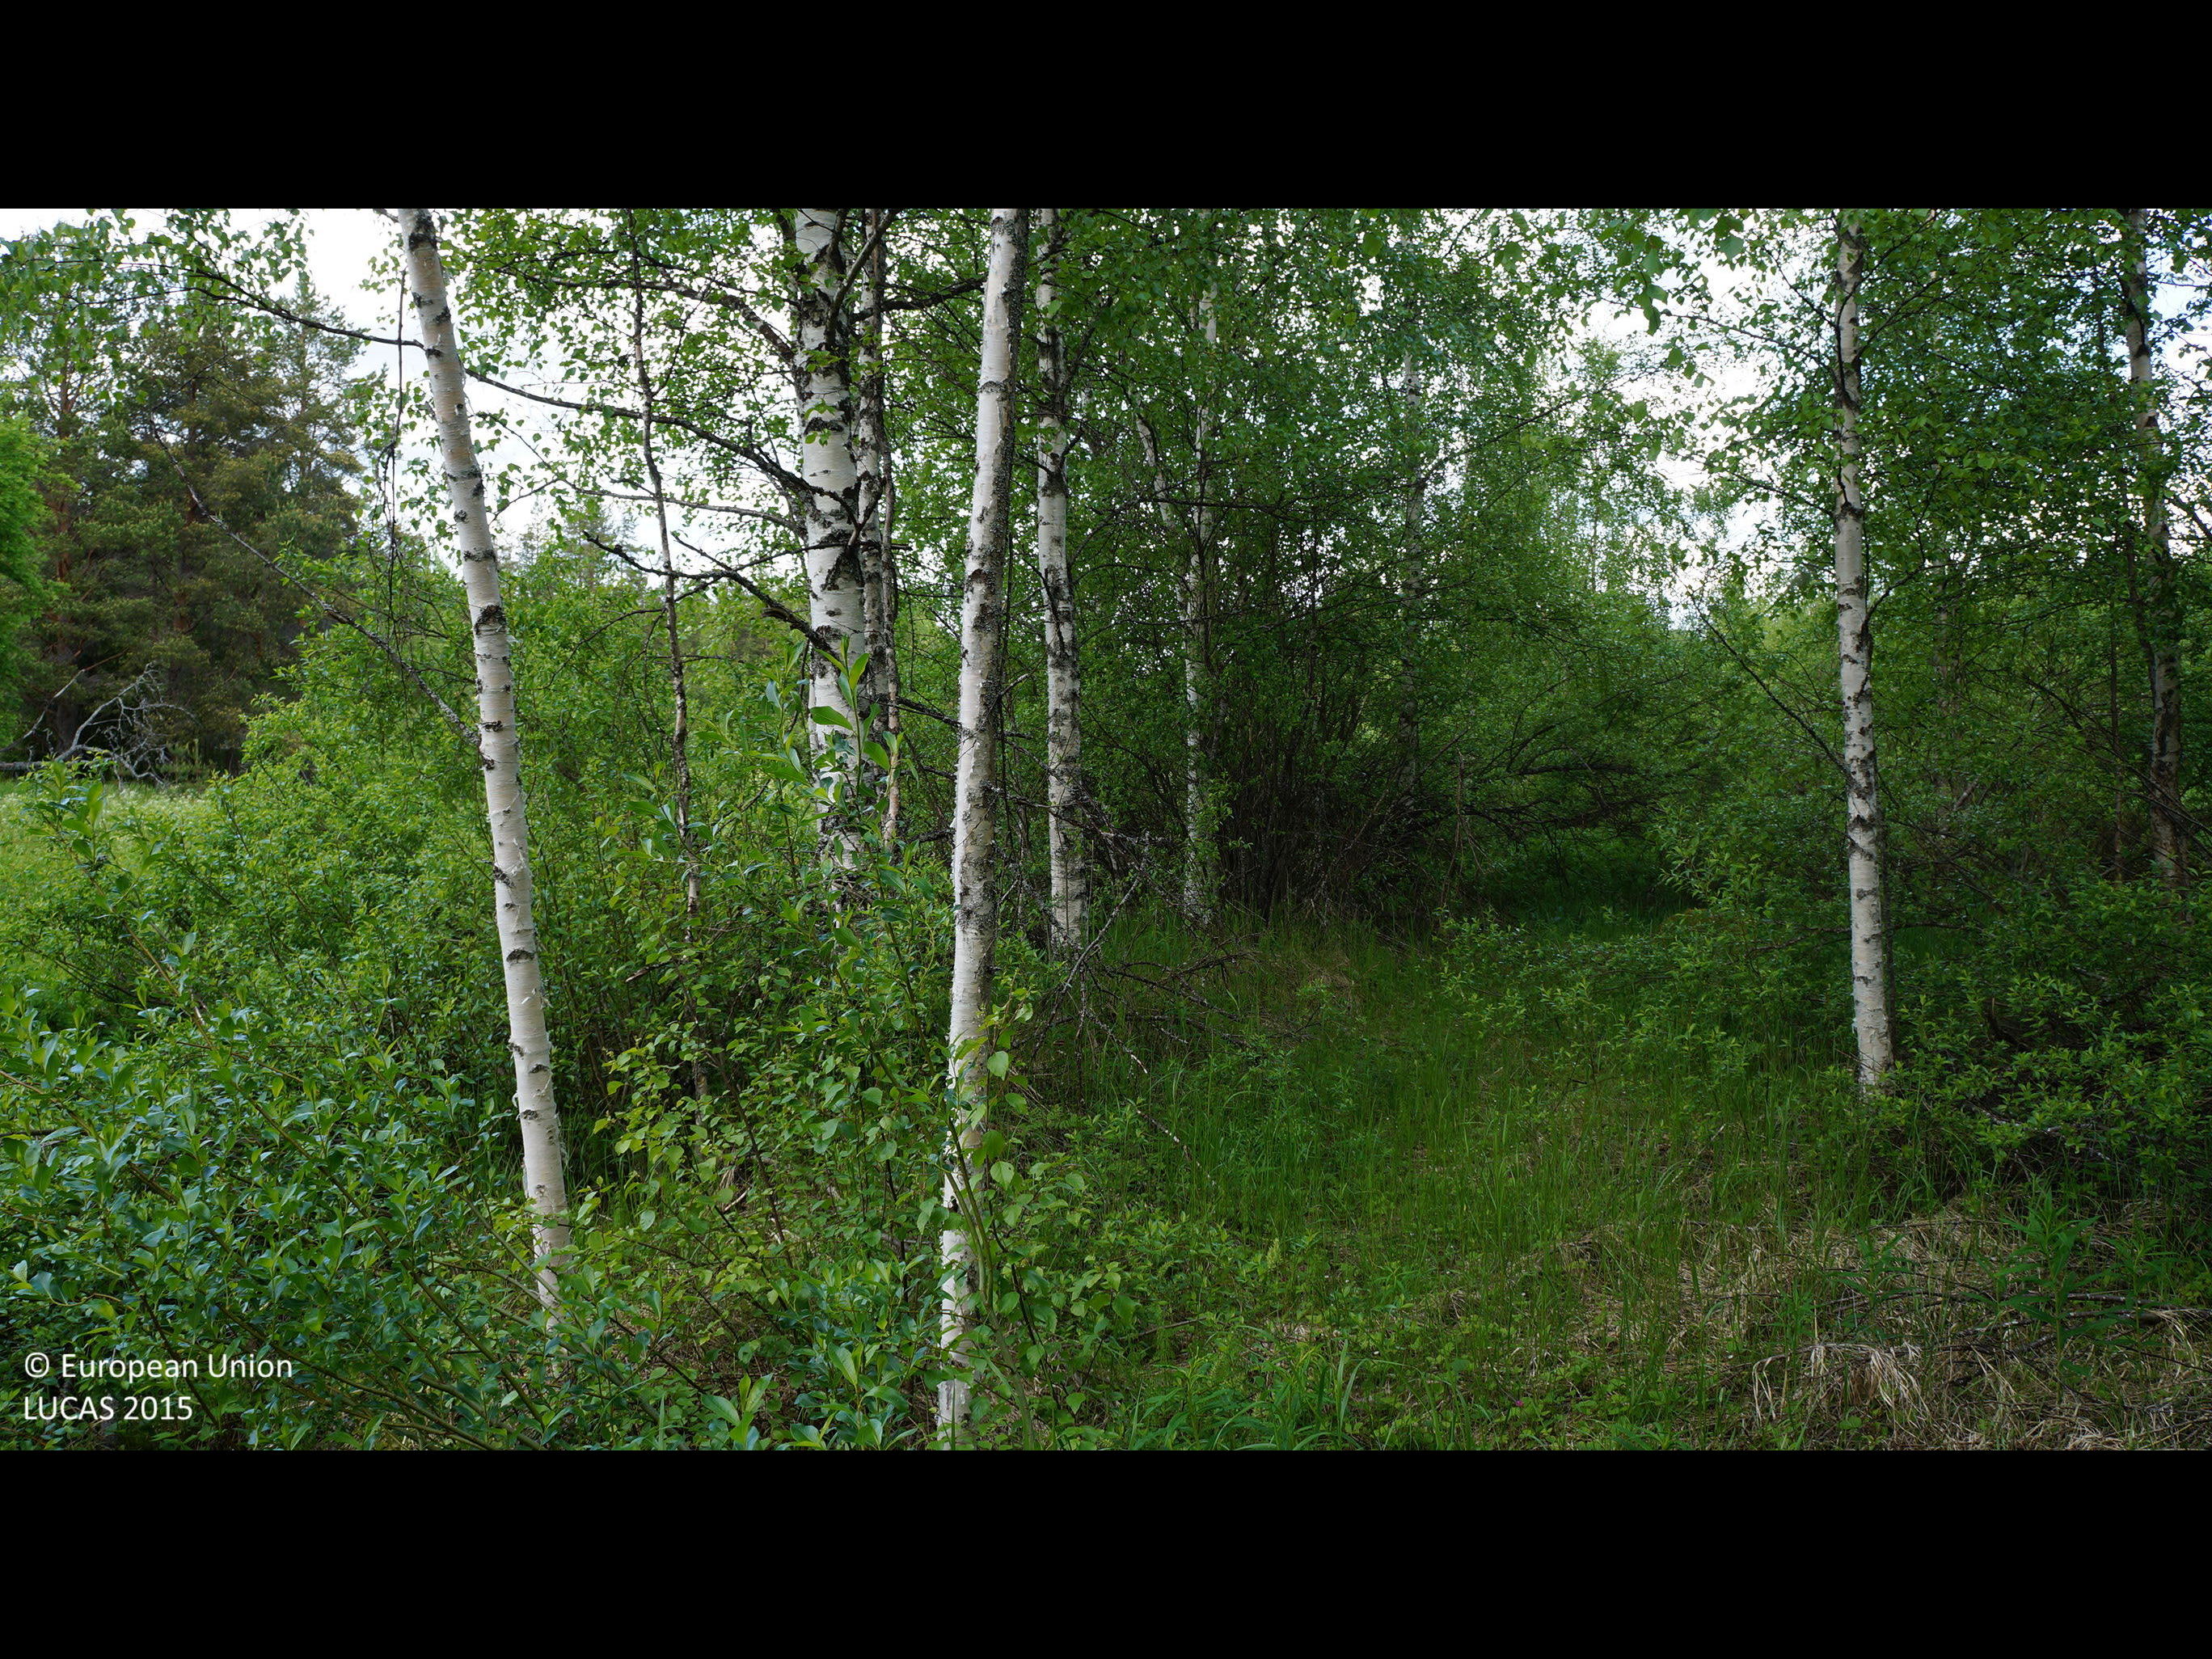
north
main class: Woodland
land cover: Broadleaved woodland
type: non-riverine alder, birch or aspen forest
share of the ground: 50 - 75 %
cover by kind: broadleaved forest trees 60 %, shrubs 20 %, herbaceous plants 15 %, coniferous forest trees 5 %
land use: Forestry
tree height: > 5 m
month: June
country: FI
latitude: 64.0920
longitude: 25.1226
